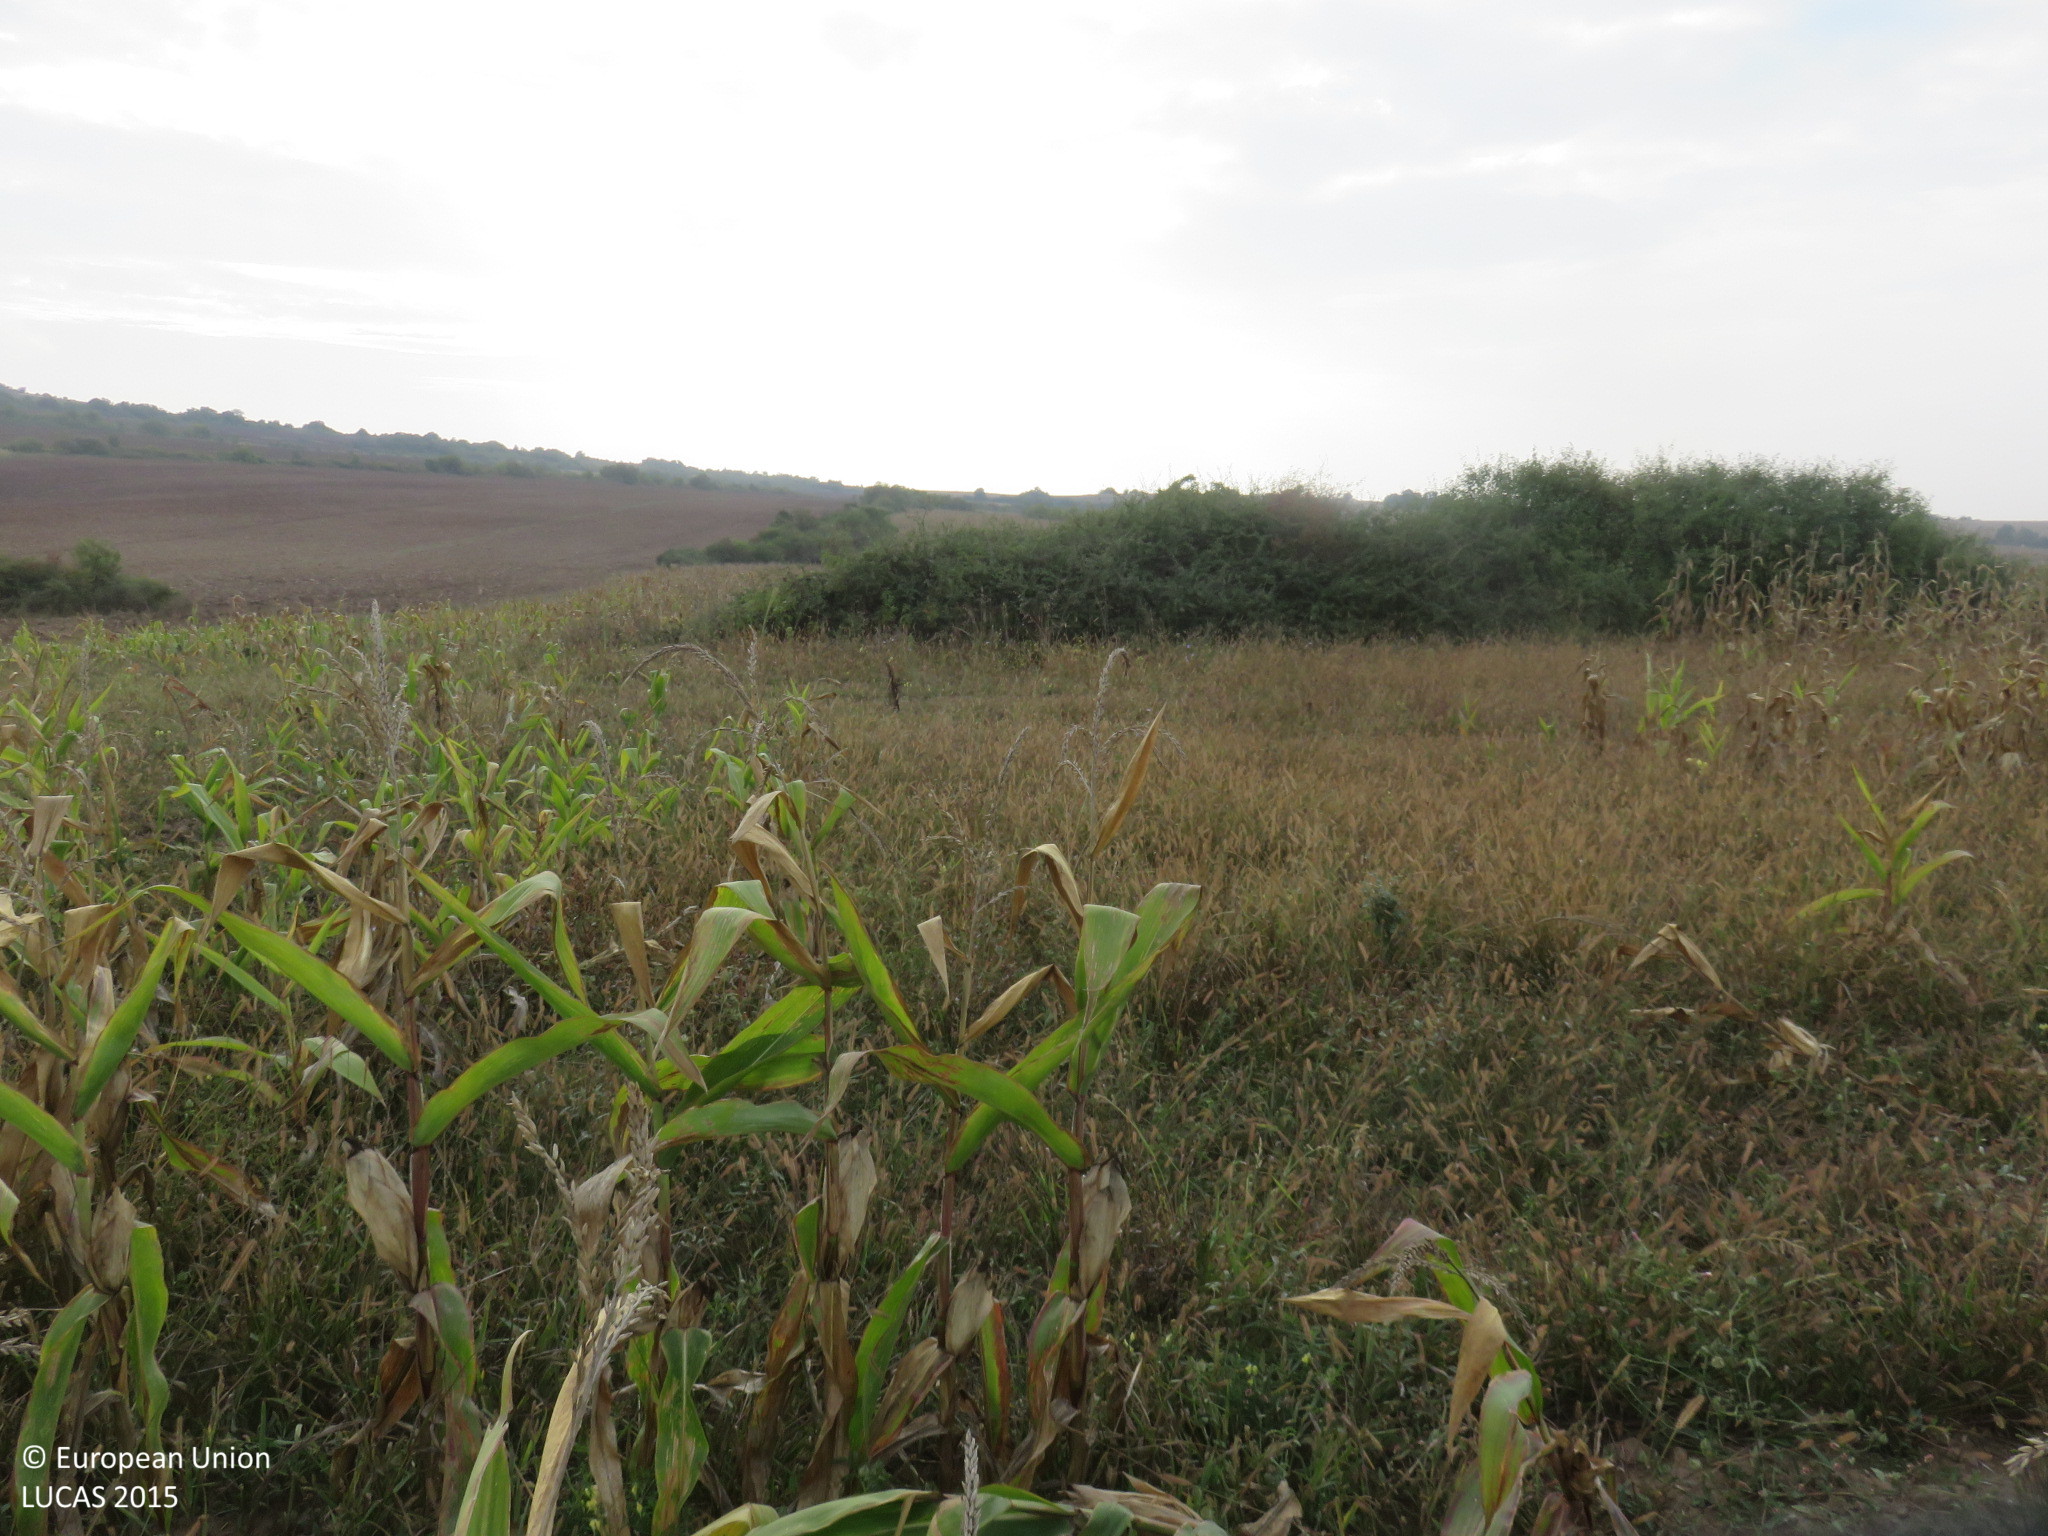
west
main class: Cropland
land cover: Maize
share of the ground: 50 - 75 %
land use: Agriculture (excluding fallow land and kitchen gardens)
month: September
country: BG
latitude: 43.1492
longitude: 24.9577
